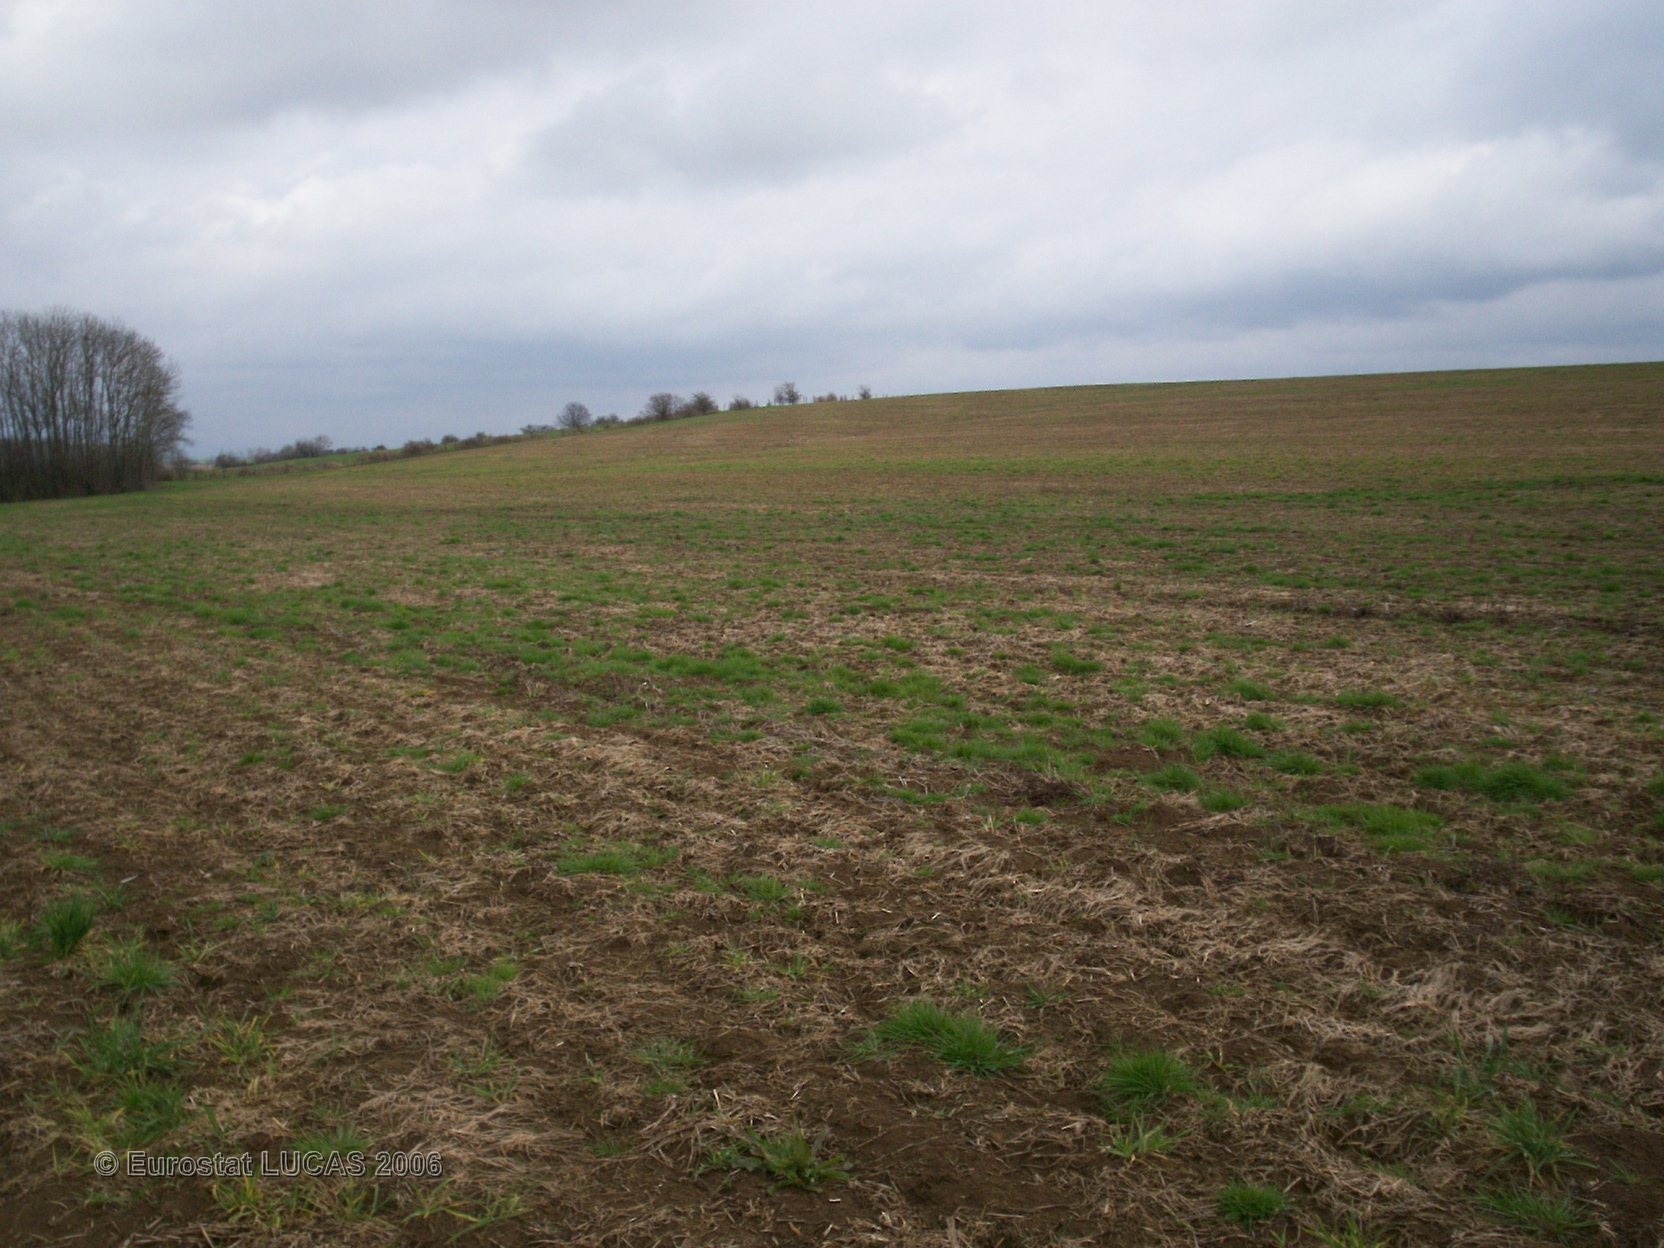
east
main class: Cropland
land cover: Maize
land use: Agriculture (excluding fallow land and kitchen gardens)
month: May
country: FR
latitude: 47.6233
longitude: 6.3688
